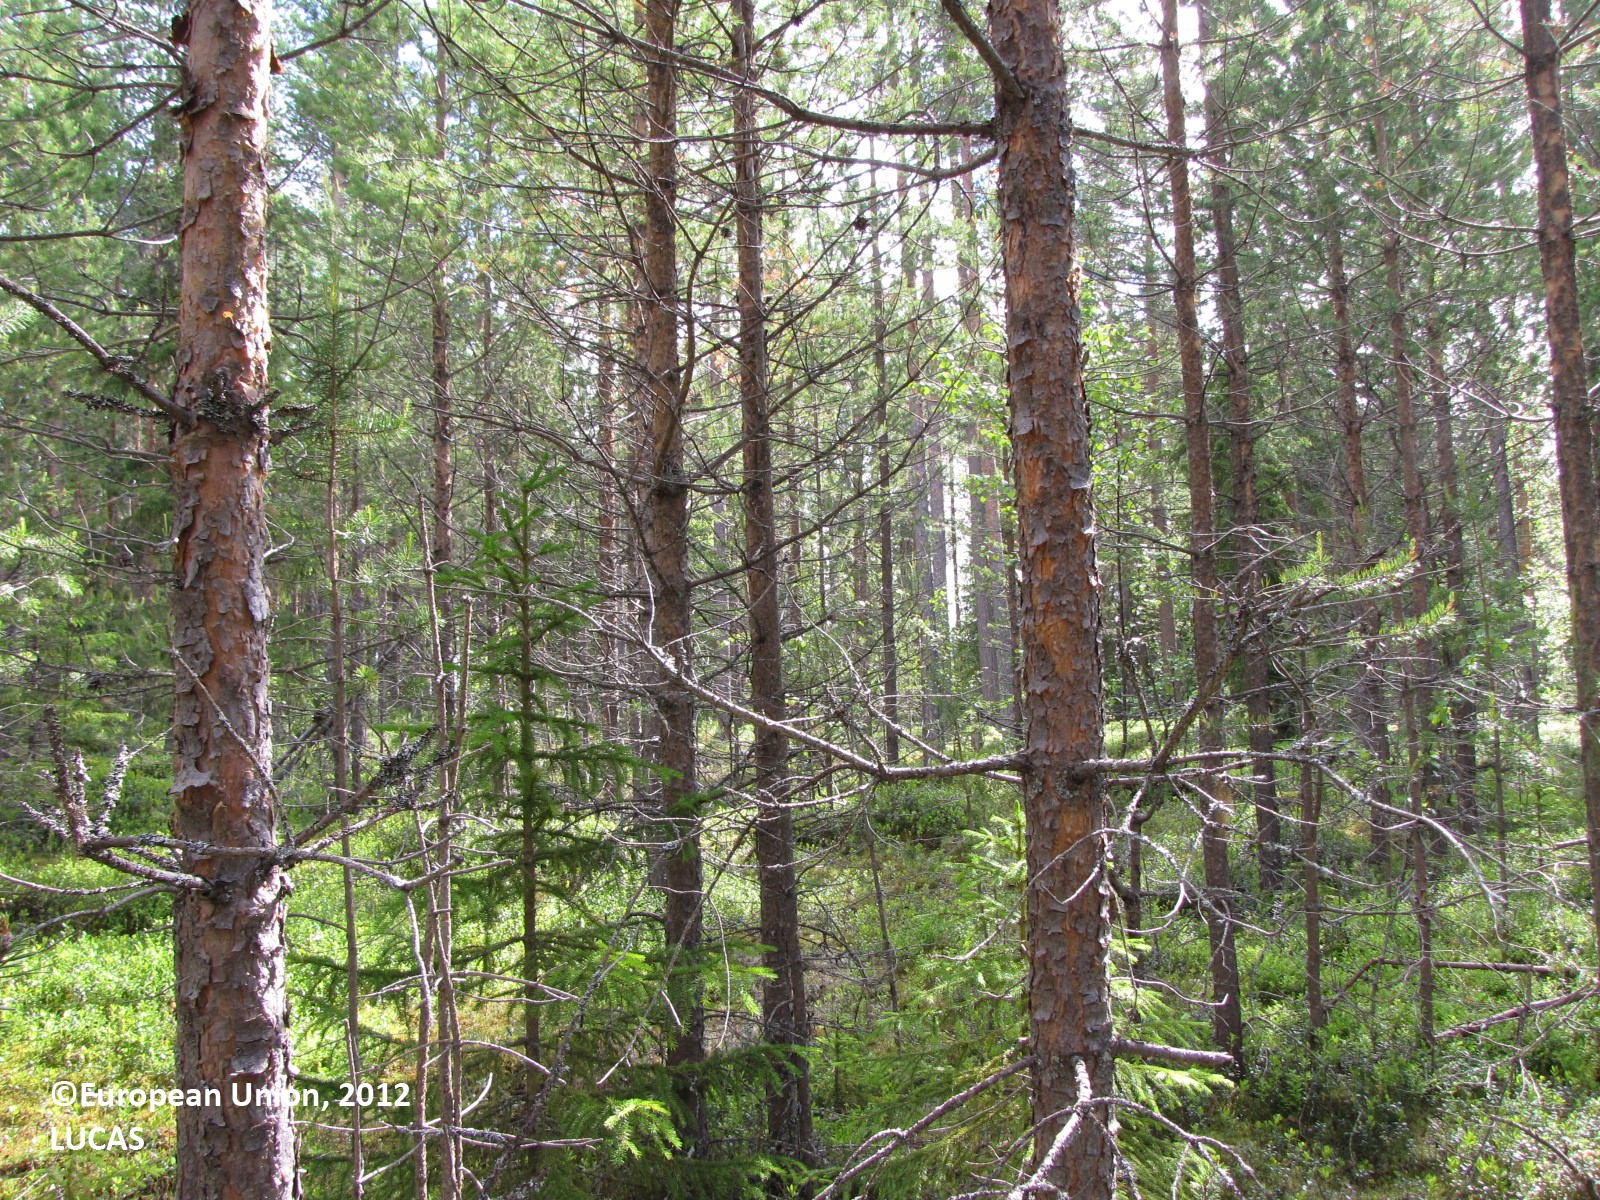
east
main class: Woodland
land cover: Pine dominated coniferous woodland
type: boreal forest
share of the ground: 50 - 75 %
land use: Forestry
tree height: > 5 m
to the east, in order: Pine dominated coniferous woodland; Pine dominated mixed woodland
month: July
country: FI
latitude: 66.1342
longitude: 25.2360
